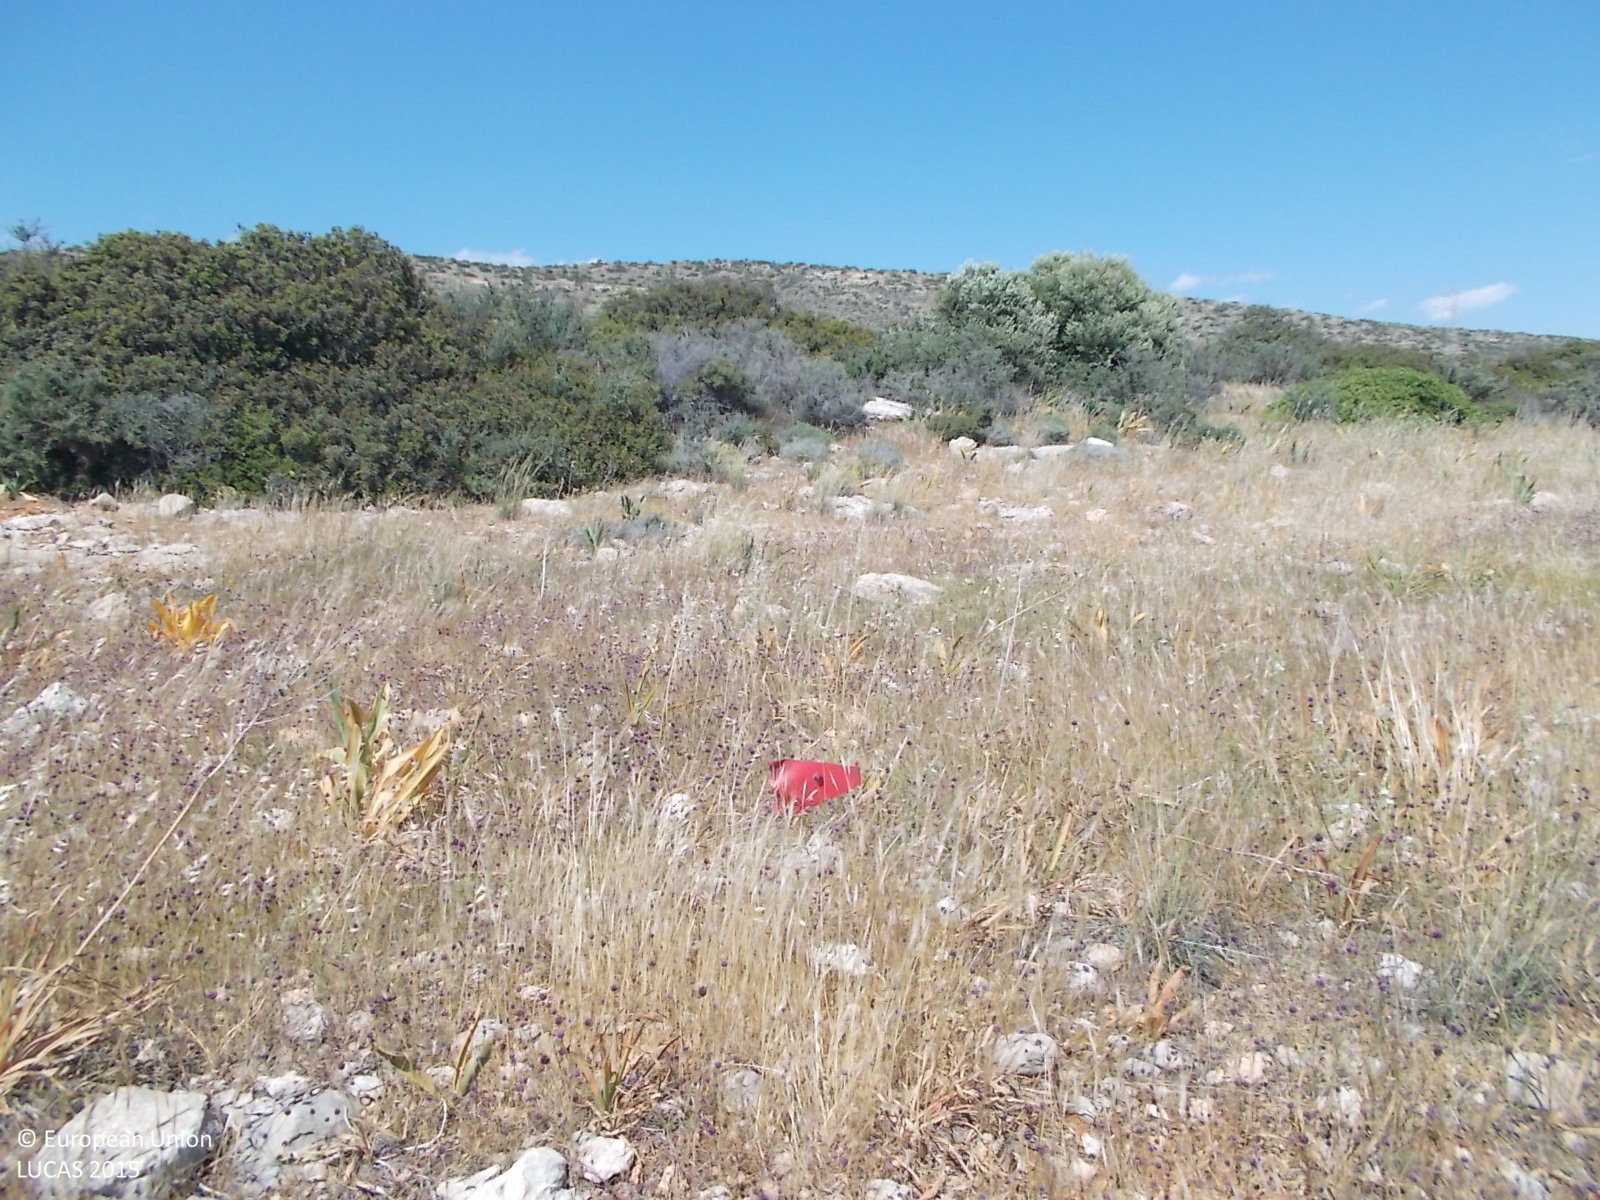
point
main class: Shrubland
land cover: Shrubland with sparse tree cover
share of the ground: 50 - 75 %
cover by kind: shrubs 65 %, herbaceous plants 20 %, broadleaved forest trees 5 %, consolidated bare surface 5 %, unconsolidated bare surface 5 %
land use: Semi-natural and natural areas not in use
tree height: < 5 m
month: April
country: CY
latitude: 34.7328
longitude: 33.0924
